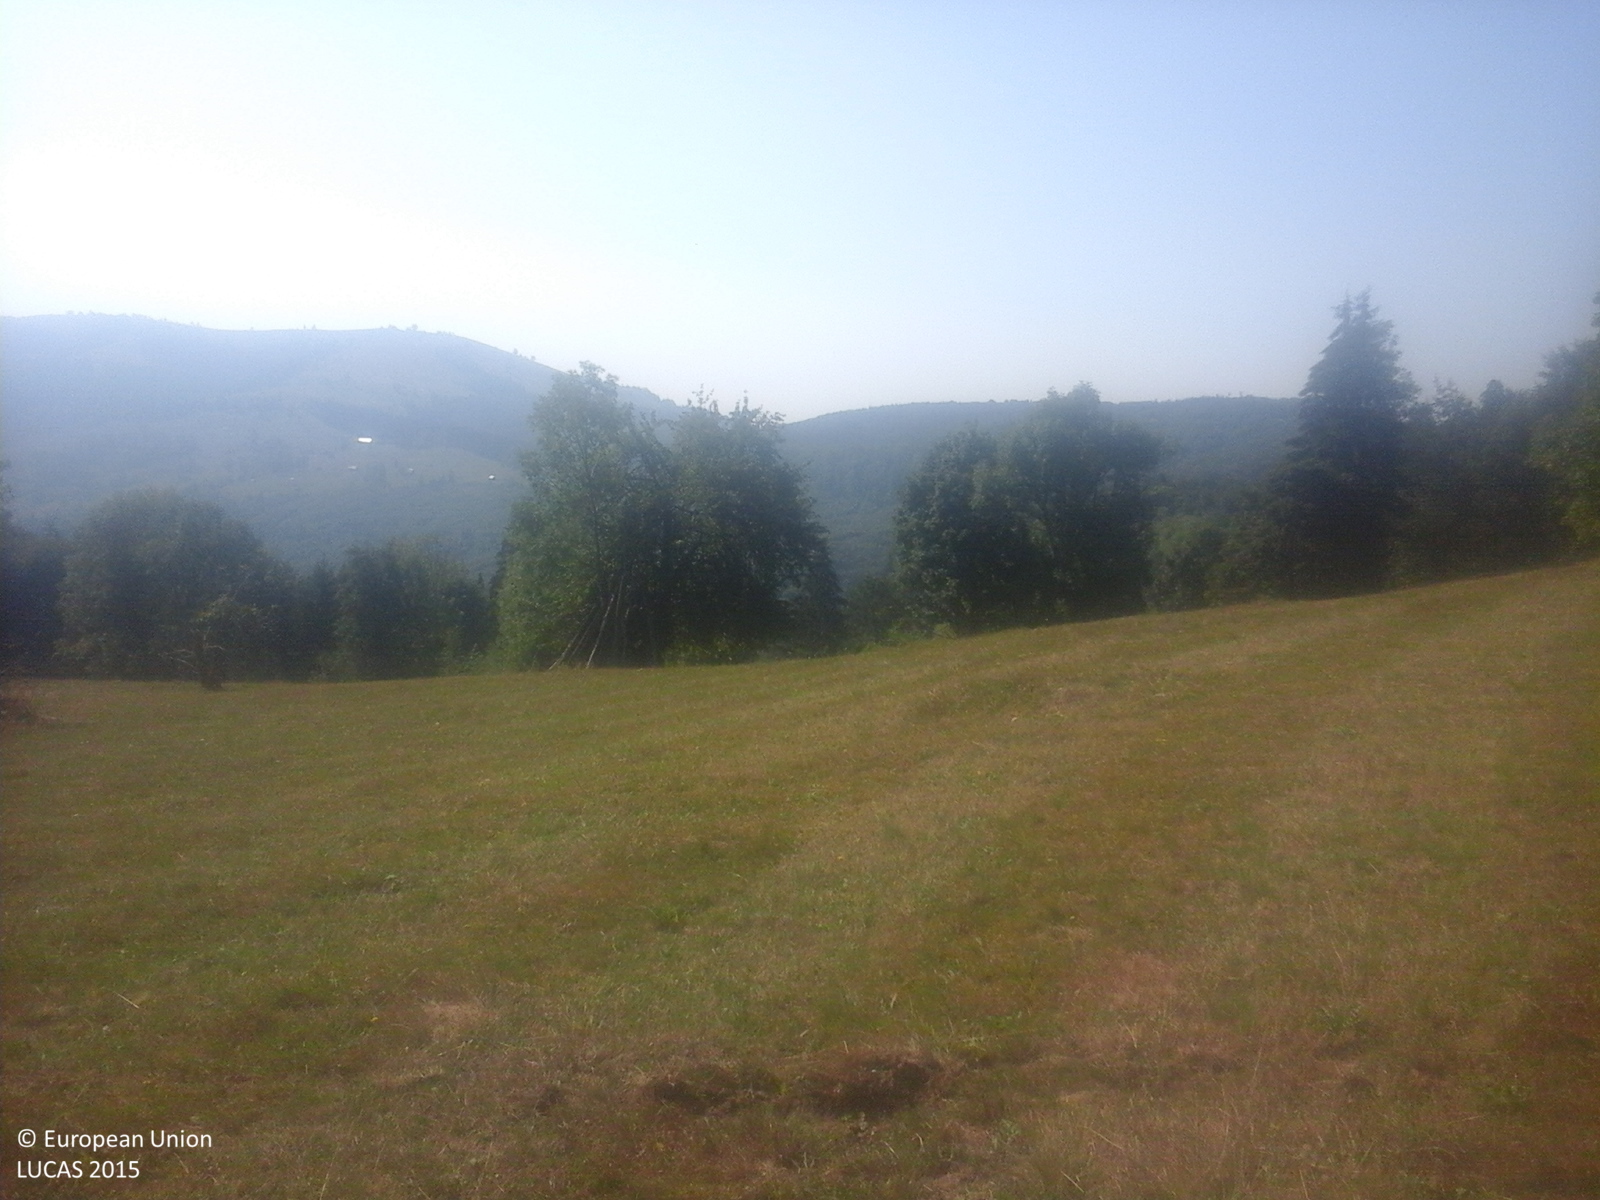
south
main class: Grassland
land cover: Grassland without tree/shrub cover
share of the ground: > 75 %
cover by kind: herbaceous plants 100 %
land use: Agriculture (excluding fallow land and kitchen gardens)
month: September
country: RO
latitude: 47.5845
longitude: 24.3853
